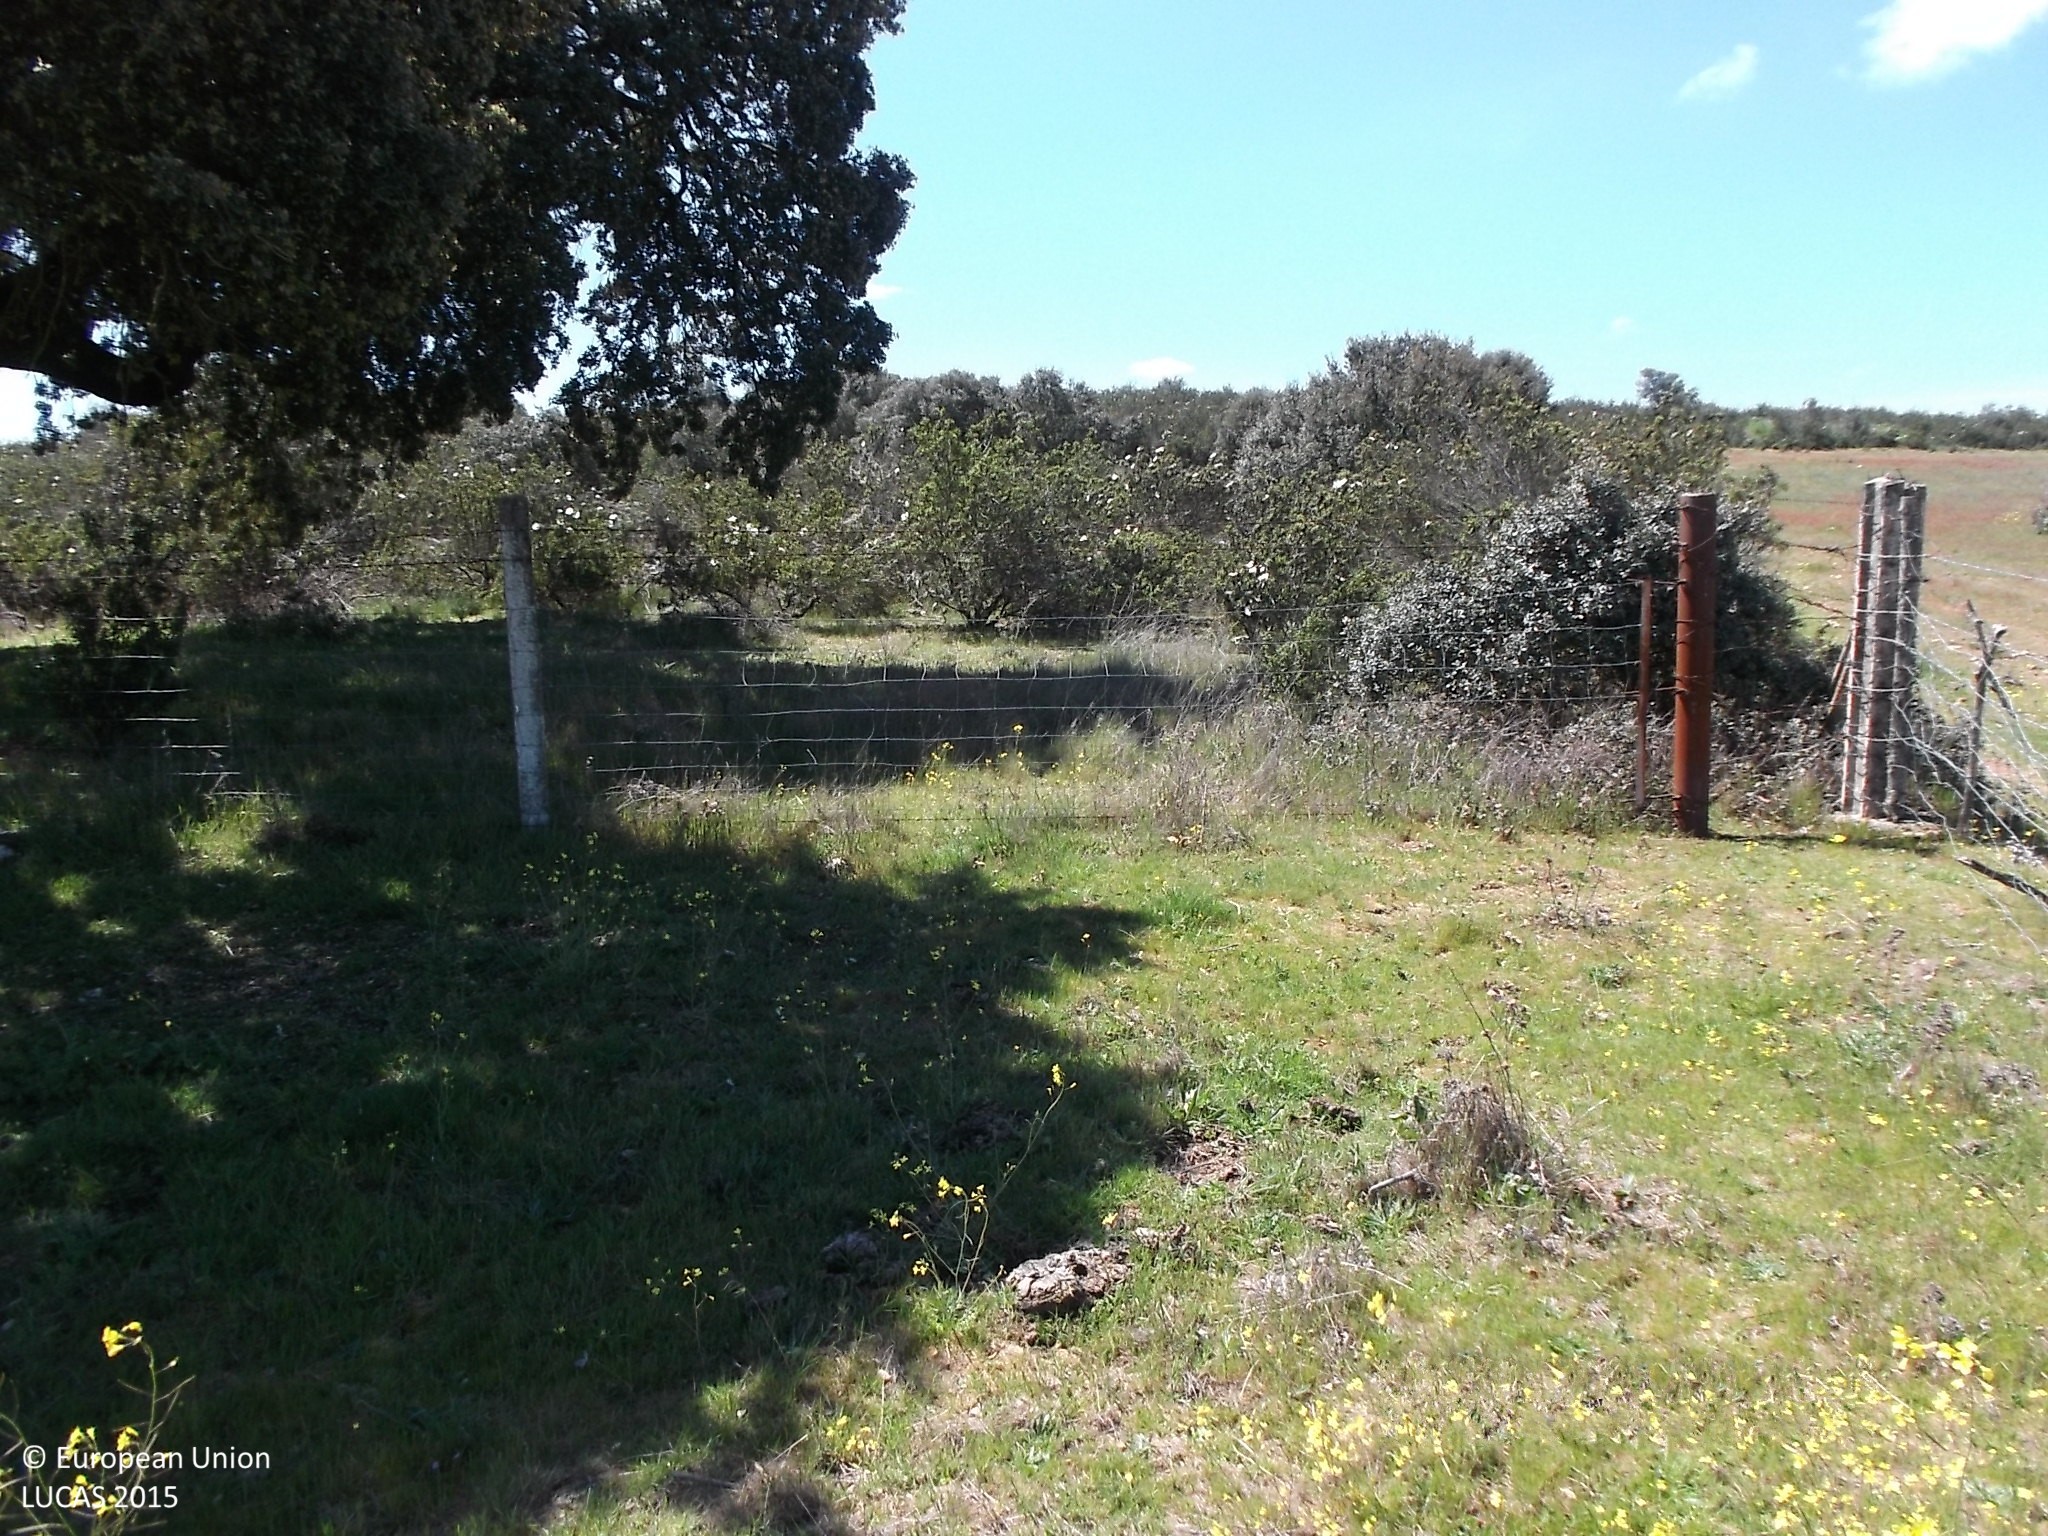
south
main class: Grassland
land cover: Grassland without tree/shrub cover
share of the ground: > 75 %
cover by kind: herbaceous plants 100 %
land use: Agriculture (excluding fallow land and kitchen gardens)
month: April
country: ES
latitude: 41.0370
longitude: -5.9157
